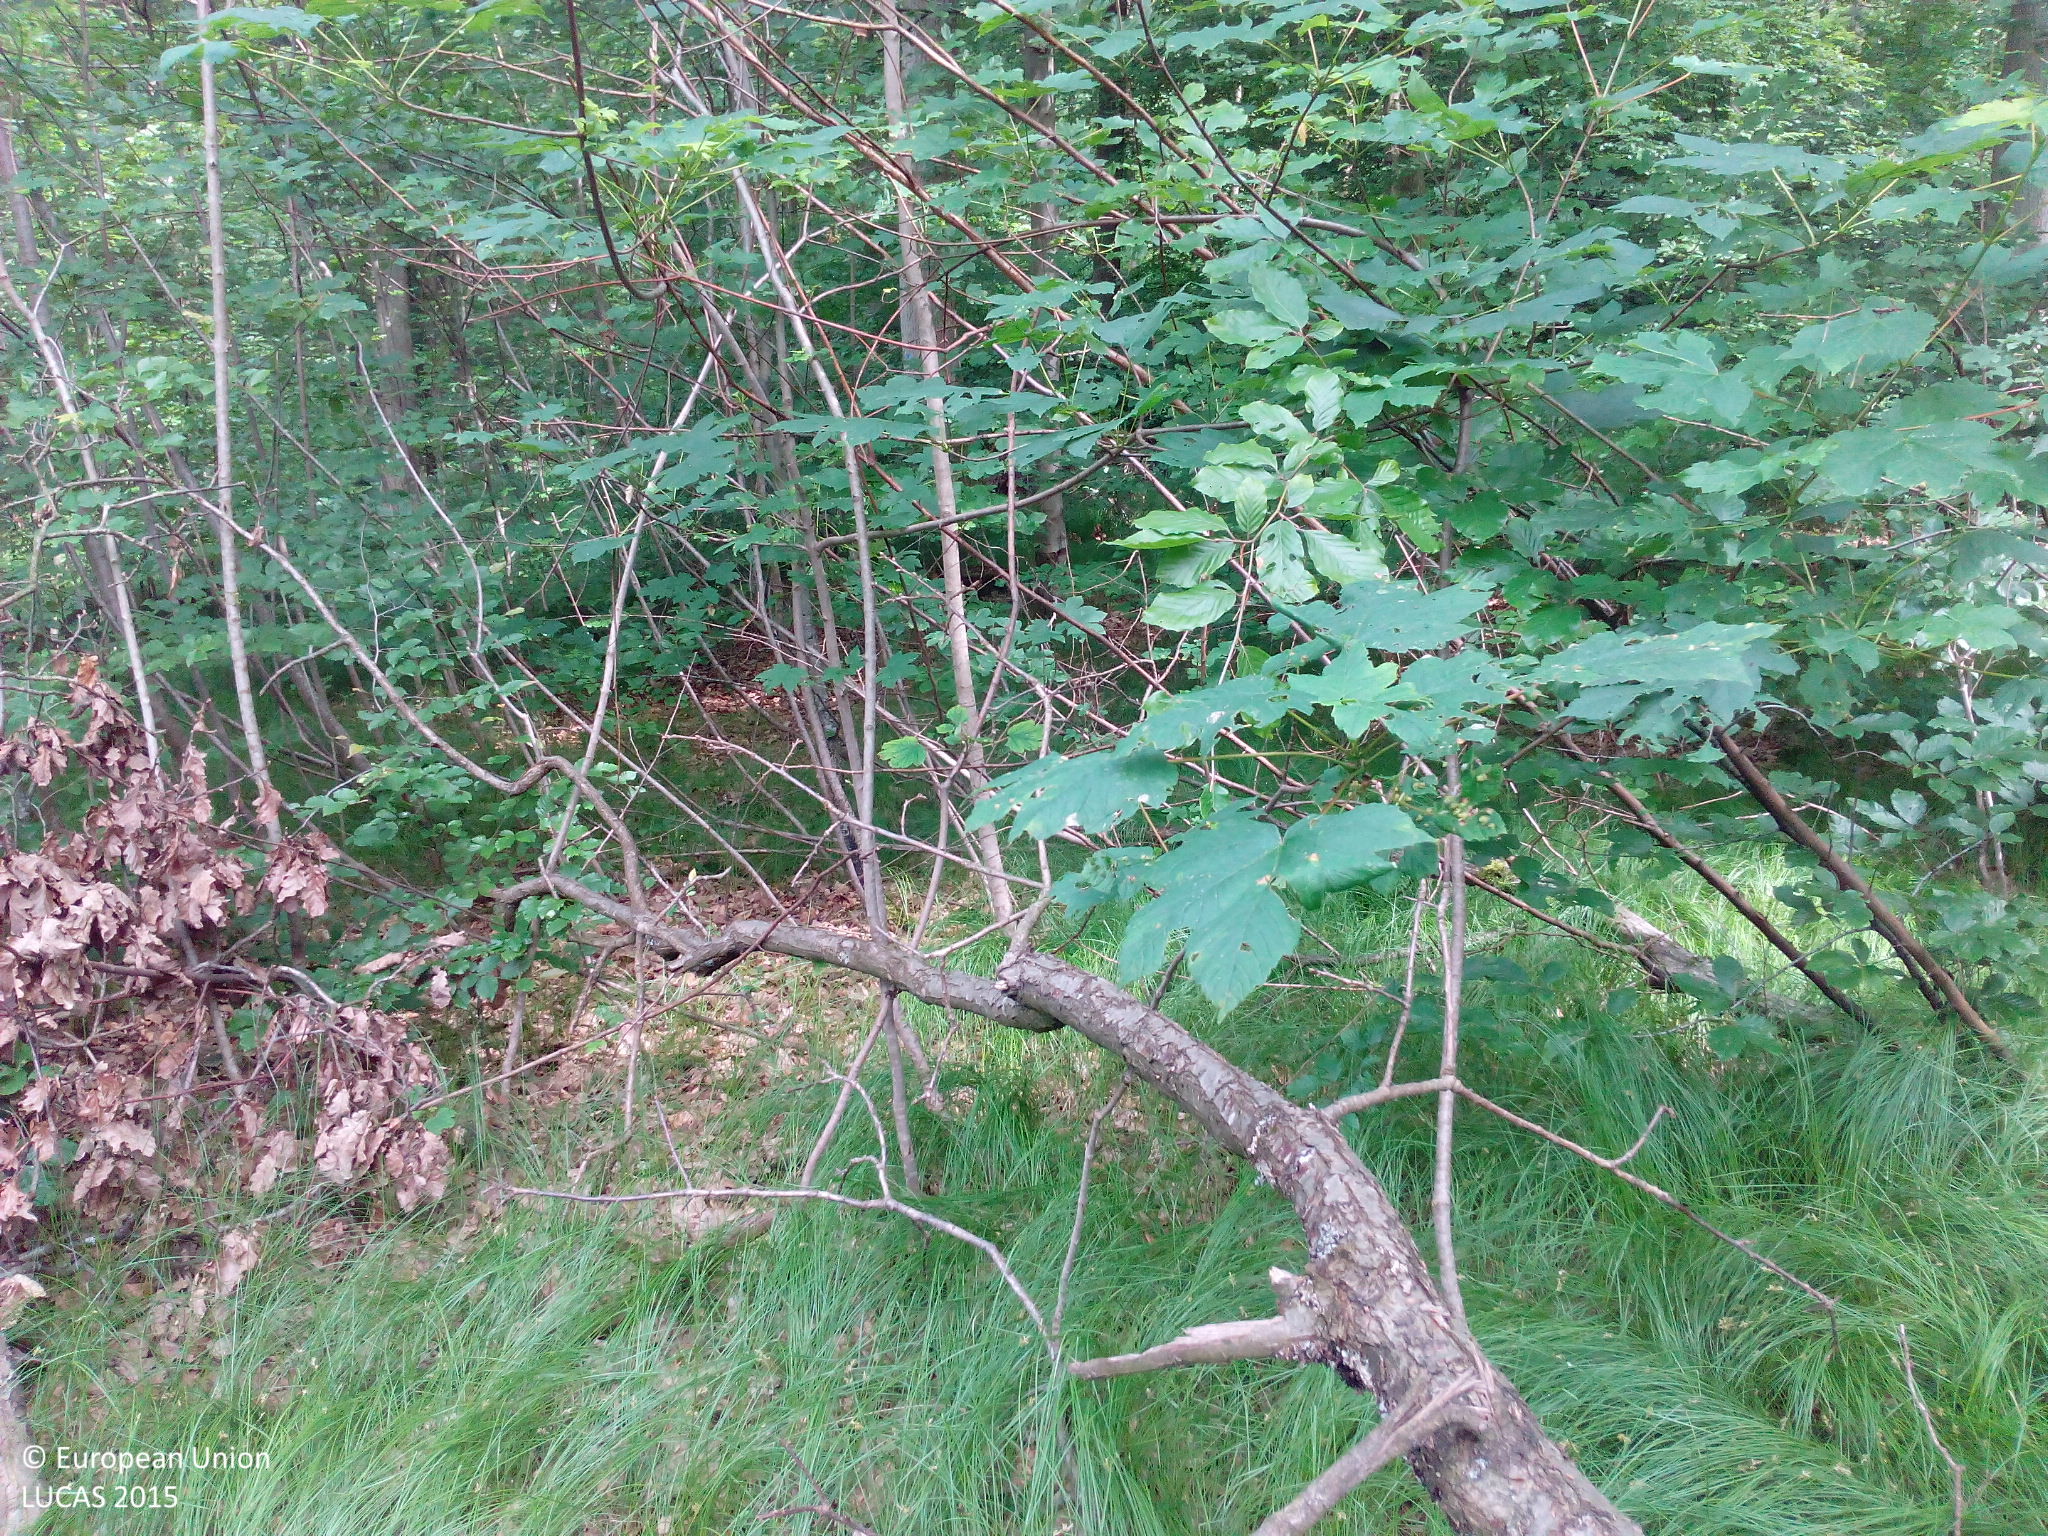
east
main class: Woodland
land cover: Broadleaved woodland
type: mesophytic deciduous forest
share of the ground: > 75 %
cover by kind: broadleaved forest trees 85 %, shrubs 10 %, herbaceous plants 5 %
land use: Forestry
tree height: > 5 m
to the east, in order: Broadleaved woodland; Tracks; Broadleaved woodland; Rivers and streams; Broadleaved woodland; Rivers and streams; Broadleaved woodland; Tracks; Broadleaved woodland
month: June
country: DE
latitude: 48.7438
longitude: 9.4155
